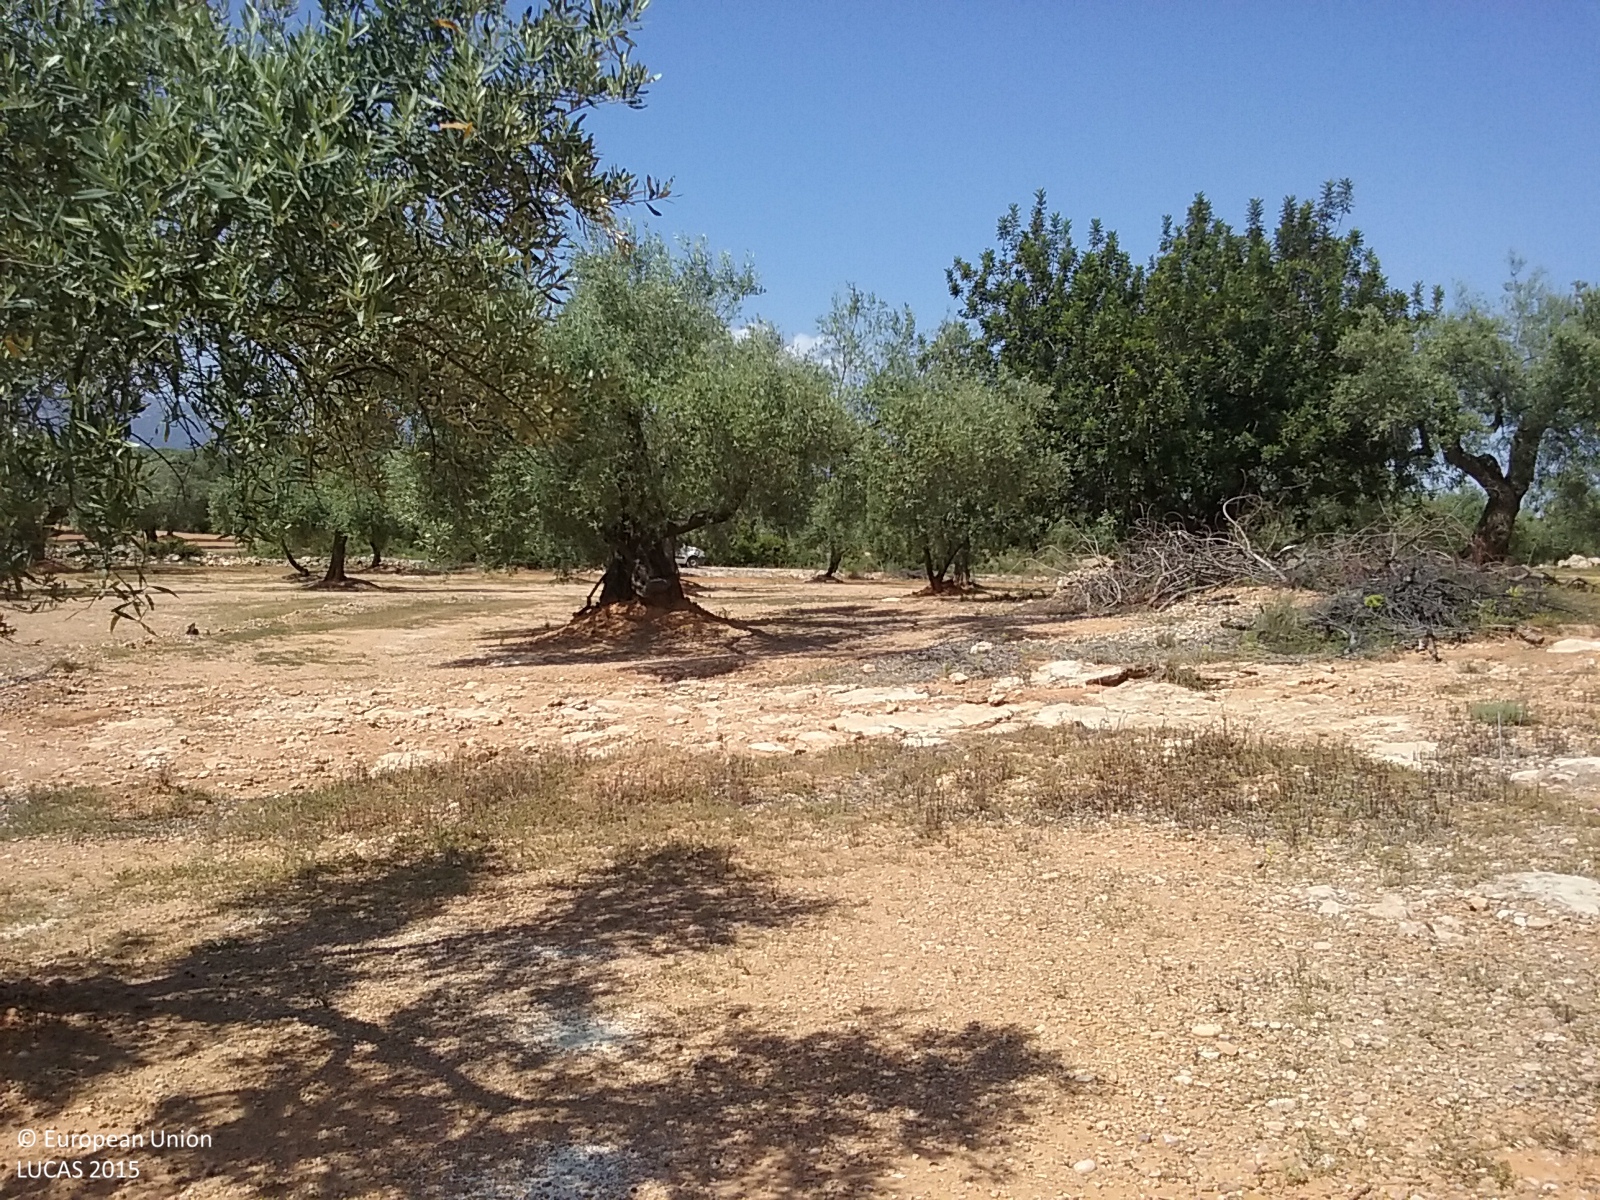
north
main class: Cropland
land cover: Olive groves
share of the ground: 25 - 50 %
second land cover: Other bare soil
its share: > 75 %
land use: Agriculture (excluding fallow land and kitchen gardens)
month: May
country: ES
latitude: 40.5660
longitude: 0.2742
